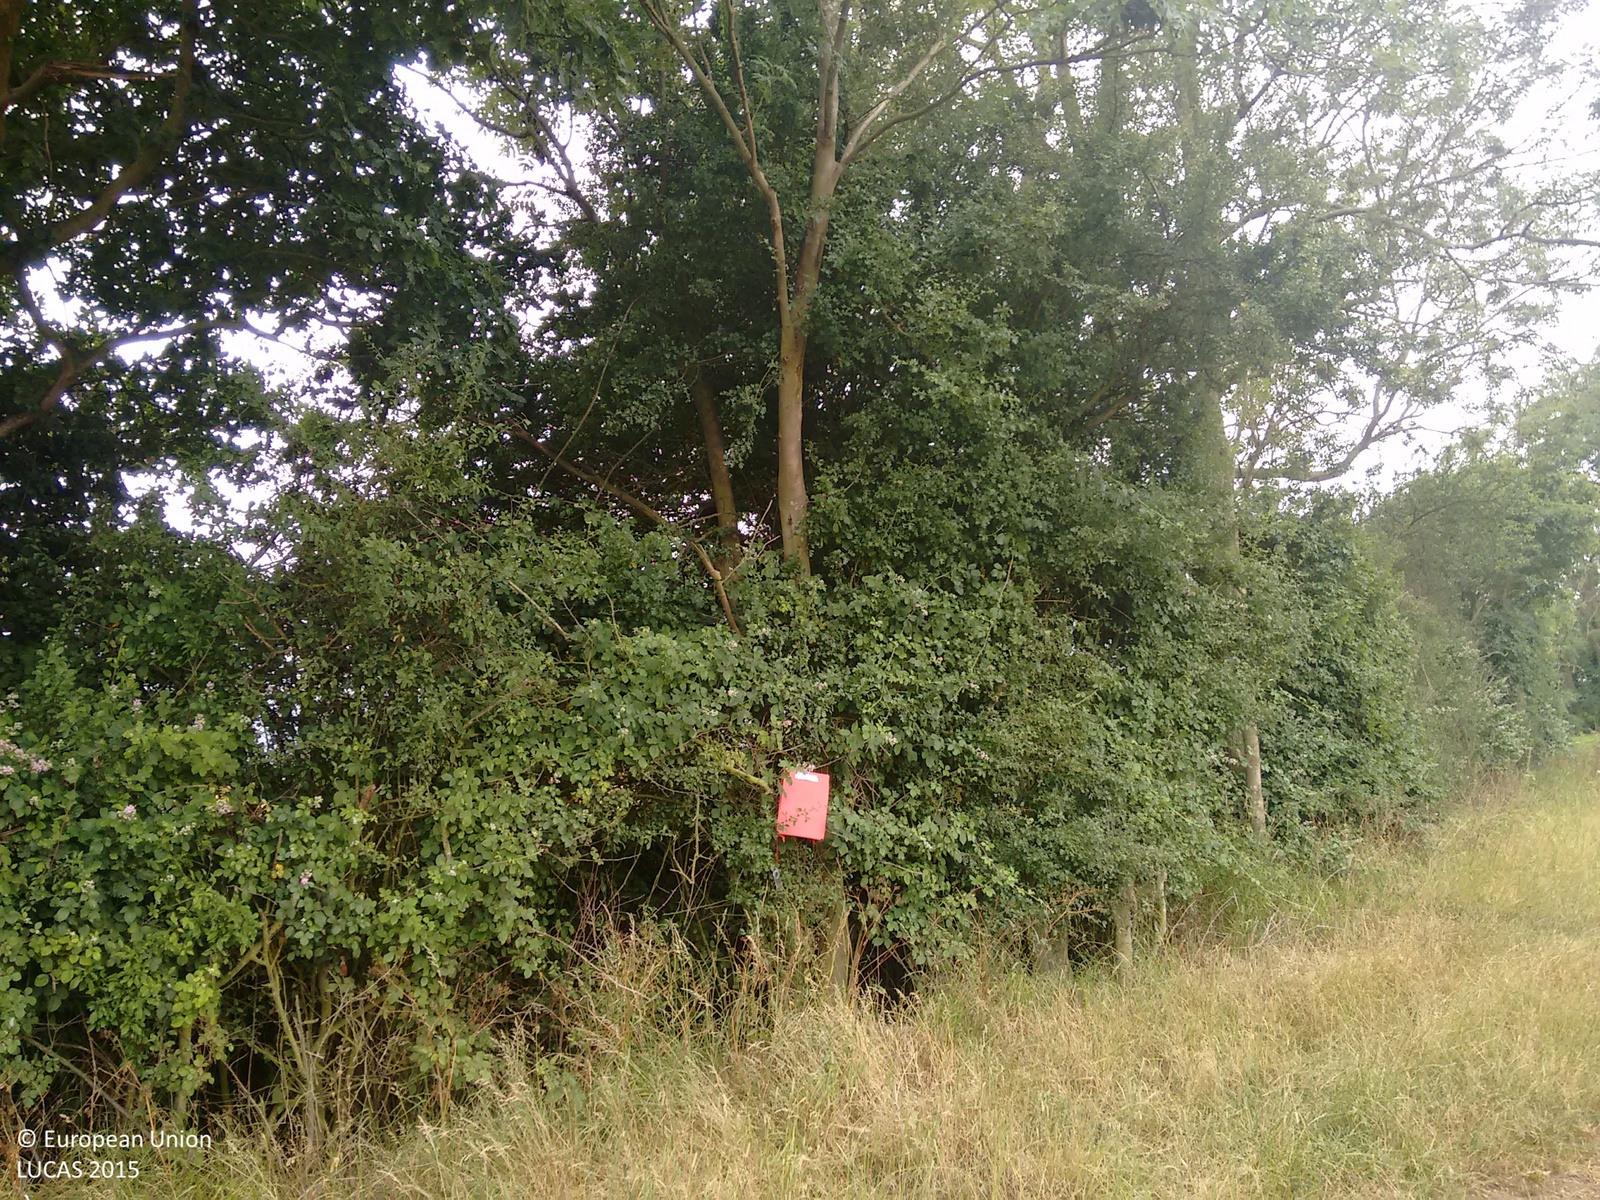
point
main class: Cropland
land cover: Common wheat
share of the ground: > 75 %
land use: Agriculture (excluding fallow land and kitchen gardens)
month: July
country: GB
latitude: 51.6390
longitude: 0.5661
